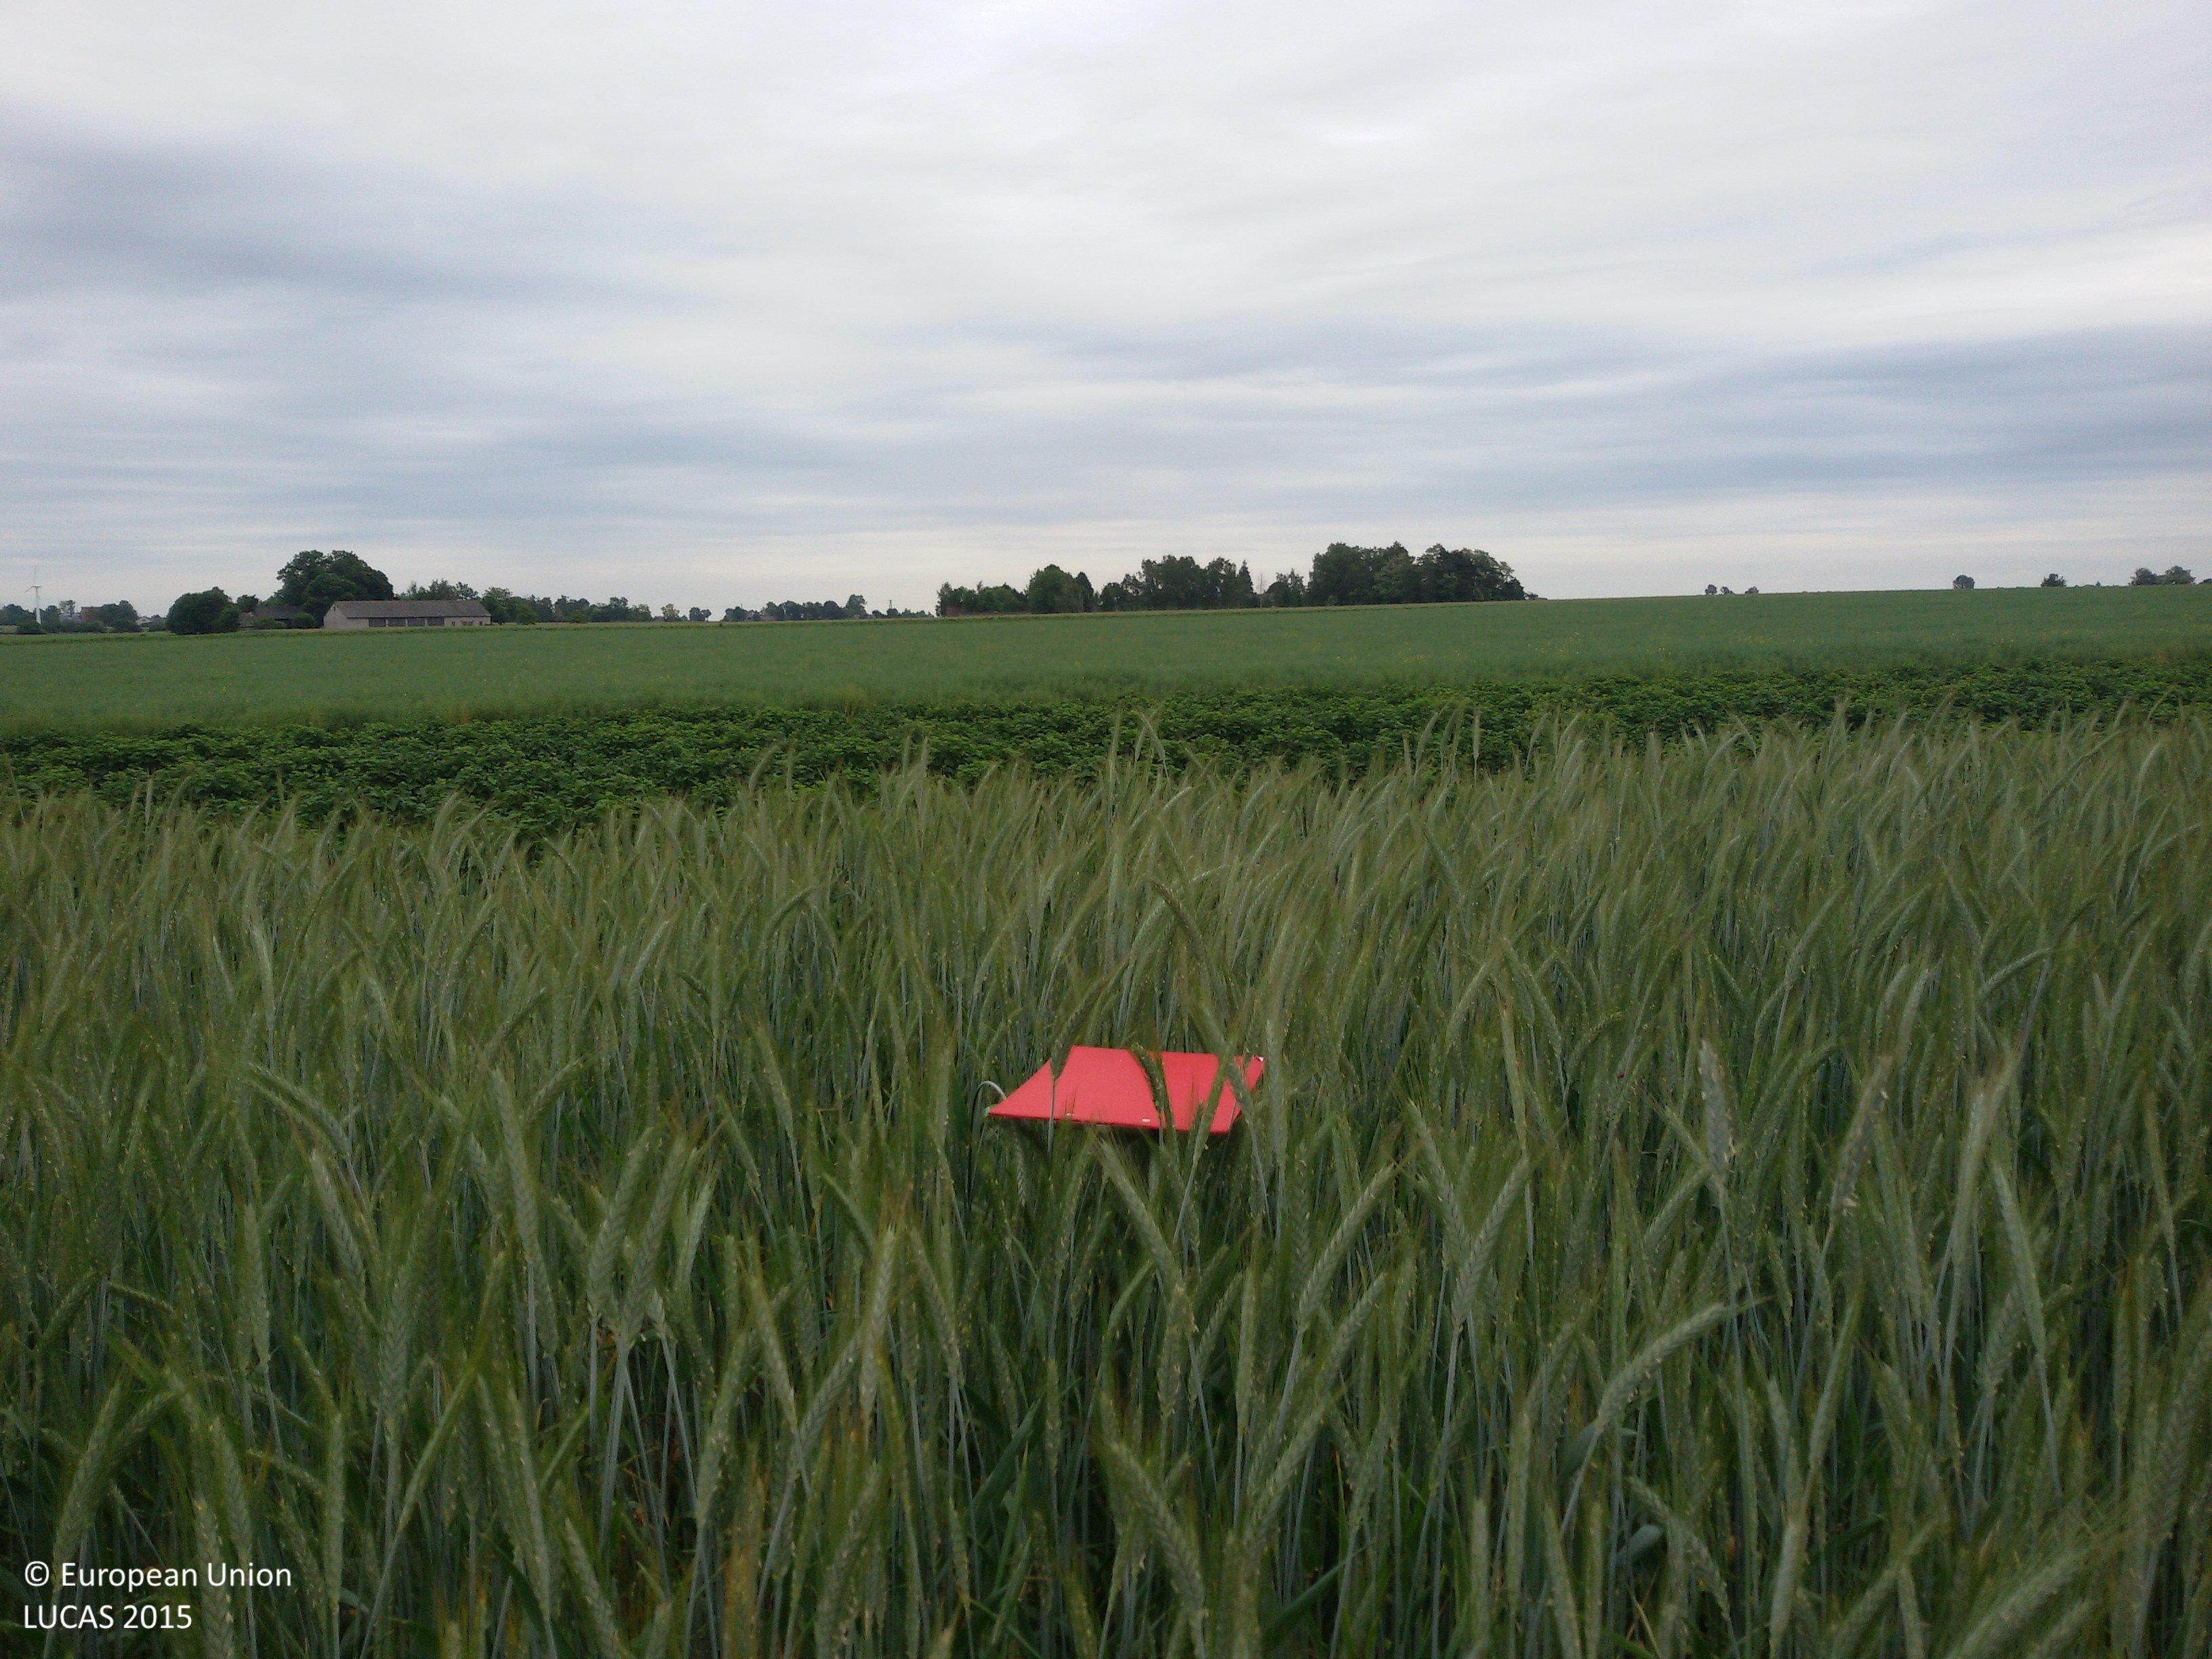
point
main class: Cropland
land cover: Triticale
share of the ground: > 75 %
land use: Agriculture (excluding fallow land and kitchen gardens)
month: June
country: PL
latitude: 51.8928
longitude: 19.8690
